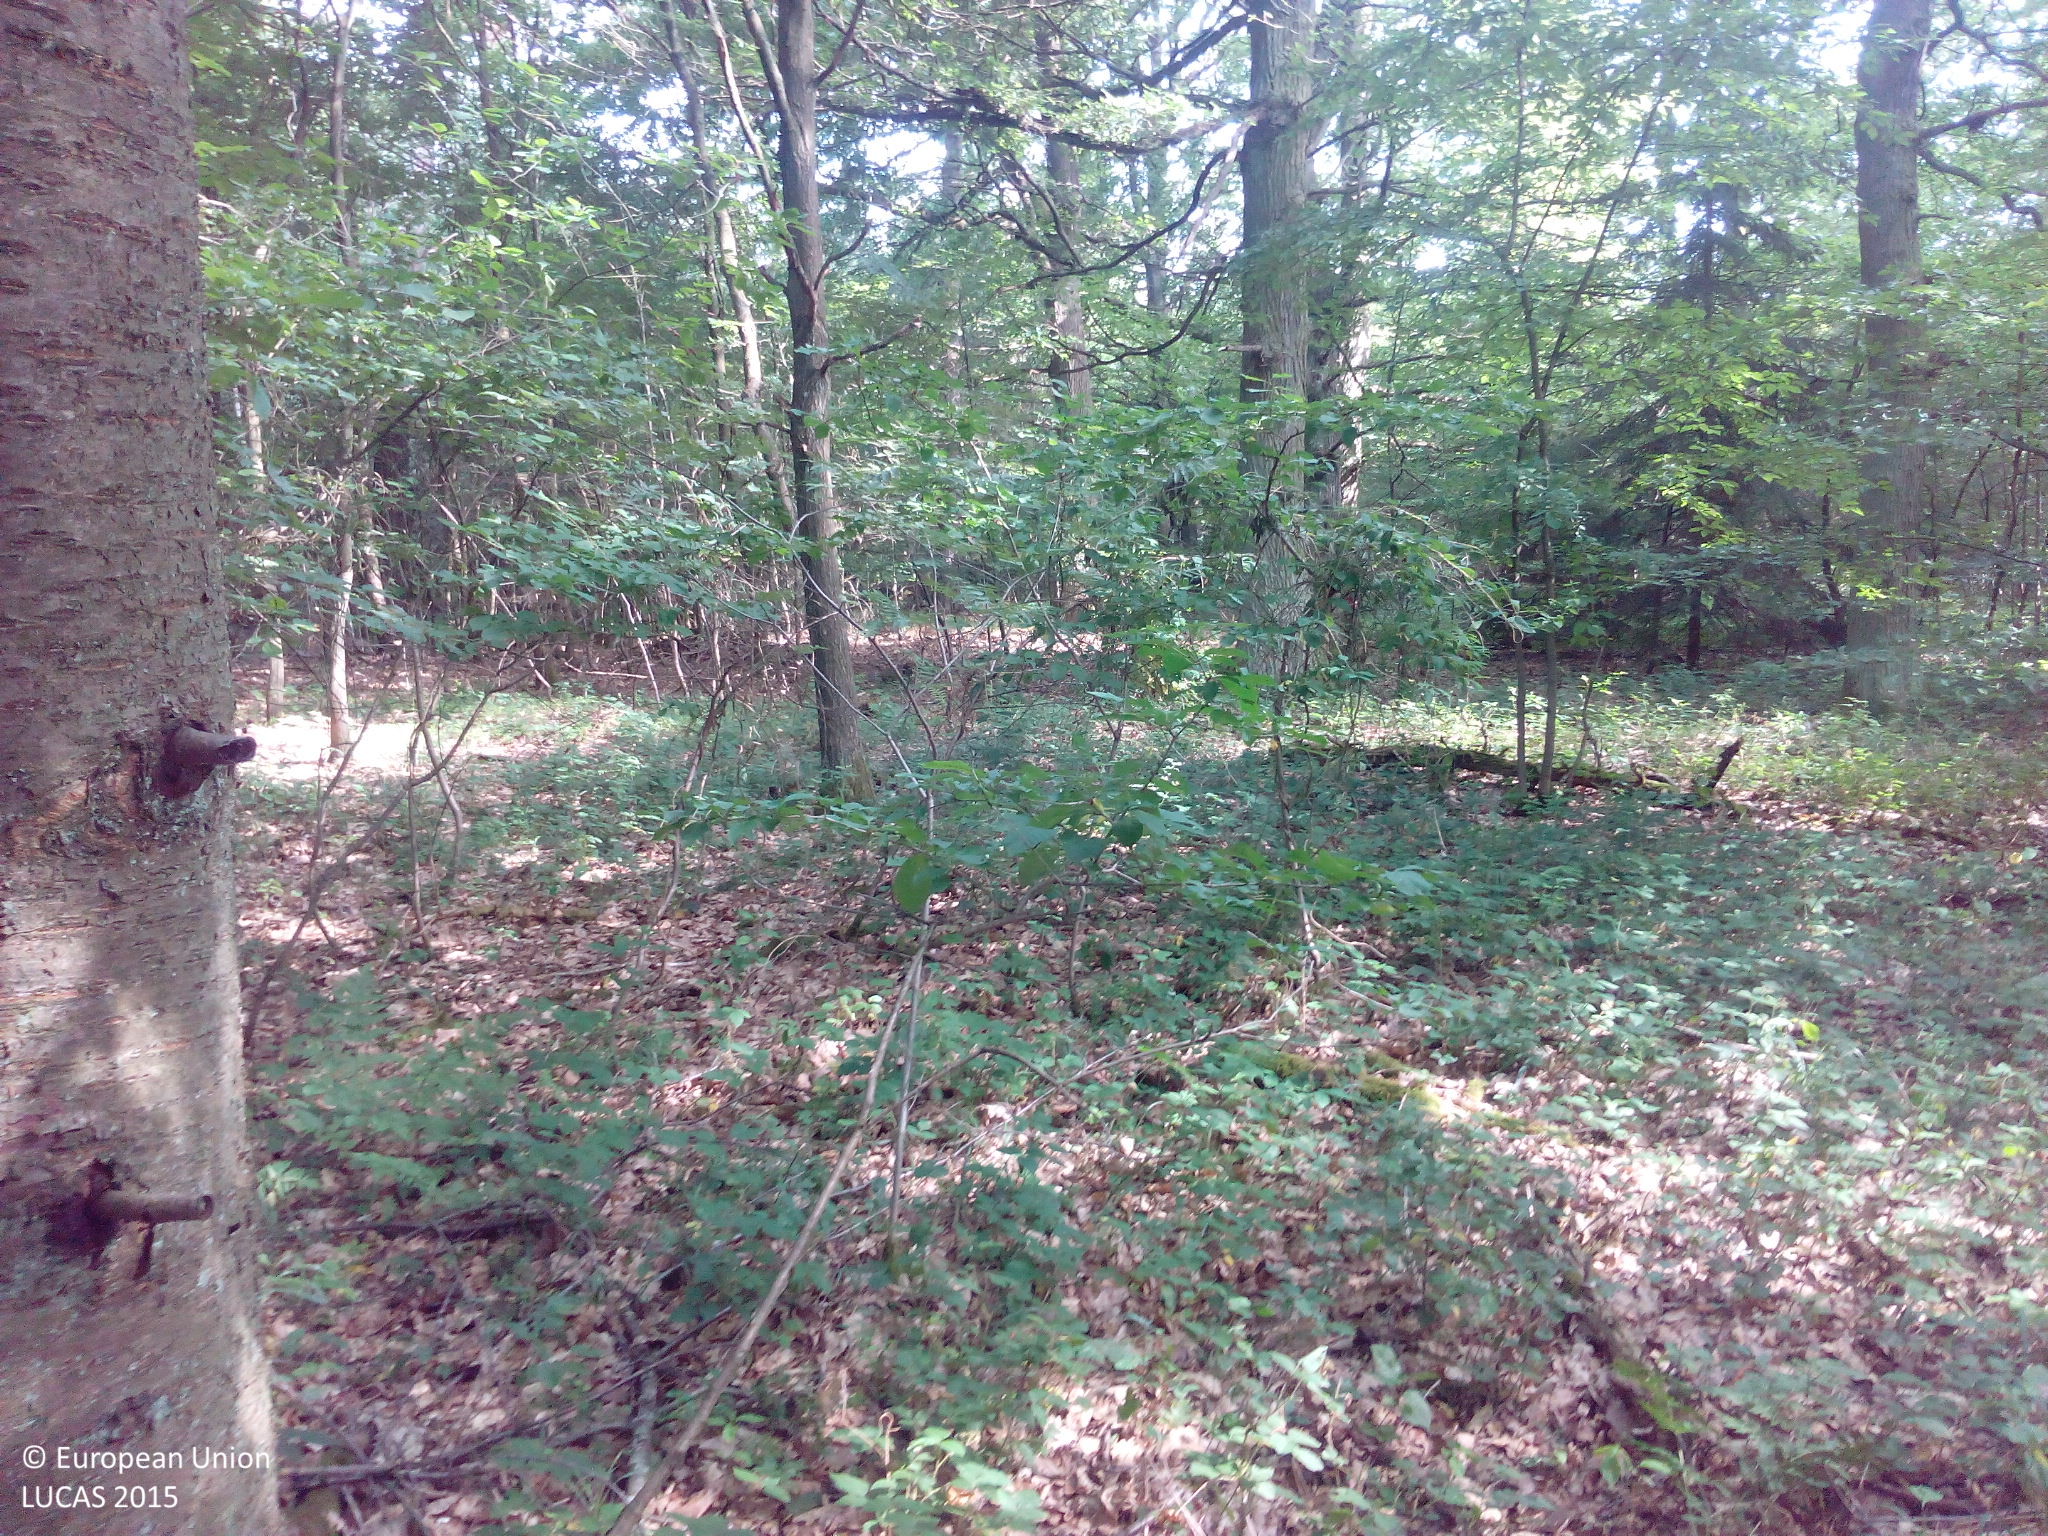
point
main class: Woodland
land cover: Broadleaved woodland
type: beech forest
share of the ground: > 75 %
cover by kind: broadleaved forest trees 75 %, coniferous forest trees 15 %, herbaceous plants 5 %, unconsolidated bare surface 5 %
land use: Forestry
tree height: > 5 m
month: July
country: DE
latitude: 49.8518
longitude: 7.5386
